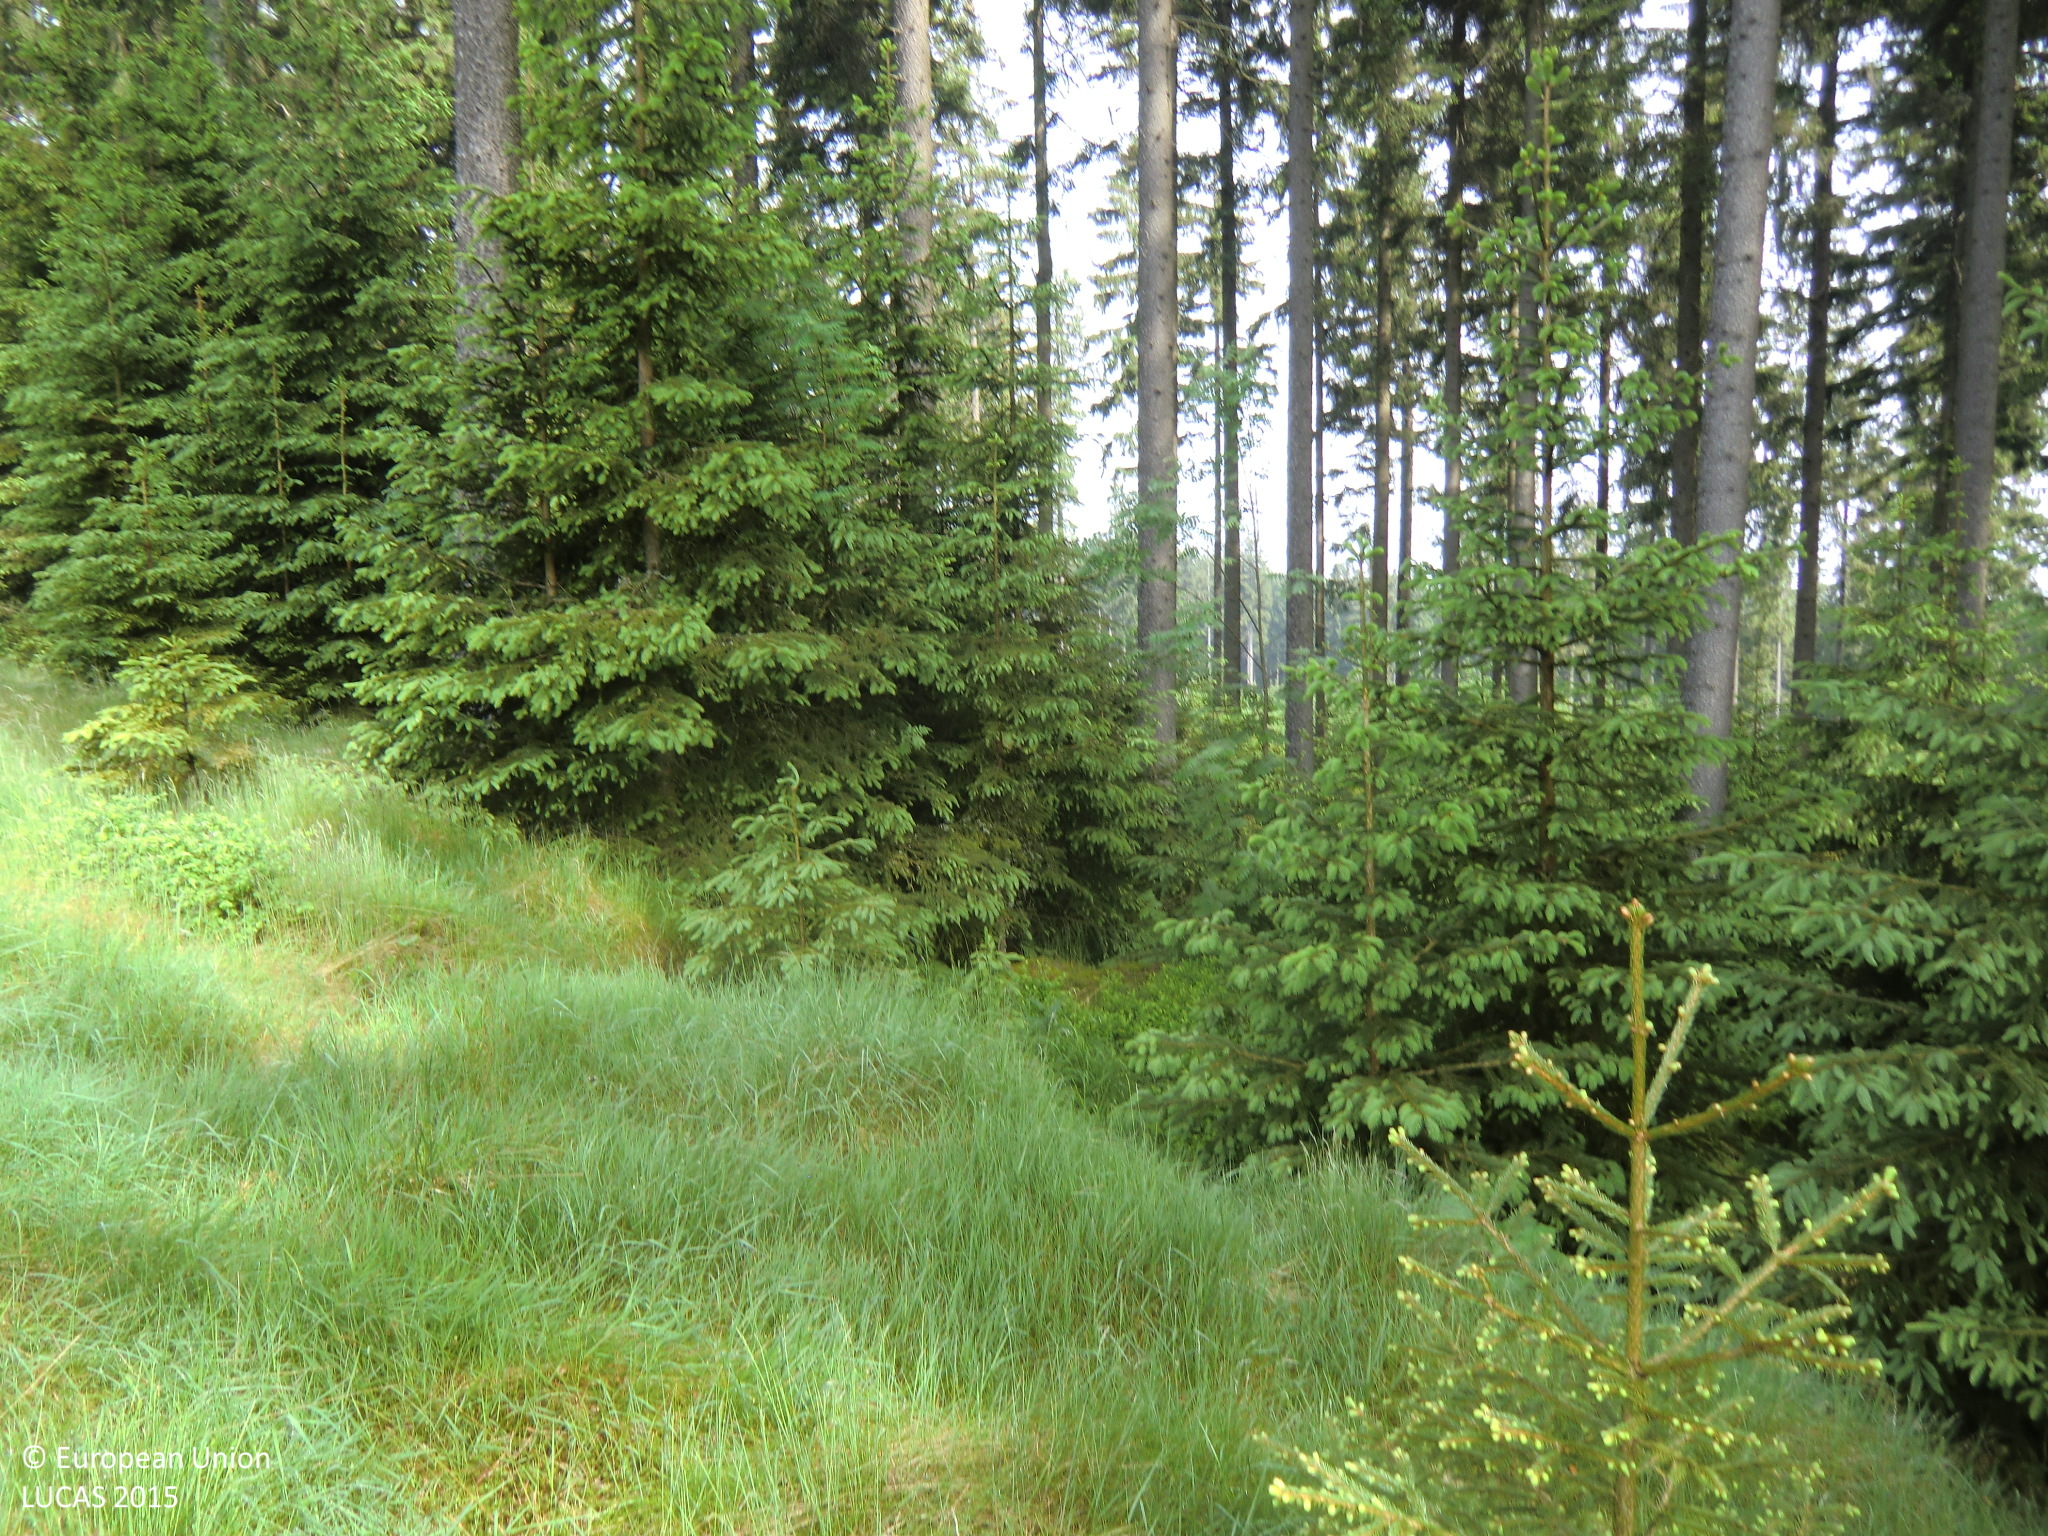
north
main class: Woodland
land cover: Other coniferous woodland
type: hemiboreal forest and nemoral coniferous forest and mixed broadleaved-coniferous forest
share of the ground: > 75 %
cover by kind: coniferous forest trees 75 %, herbaceous plants 15 %, lichens and mosses 10 %
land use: Forestry
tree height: > 5 m
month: June
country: AT
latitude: 48.6085
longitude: 14.7346
